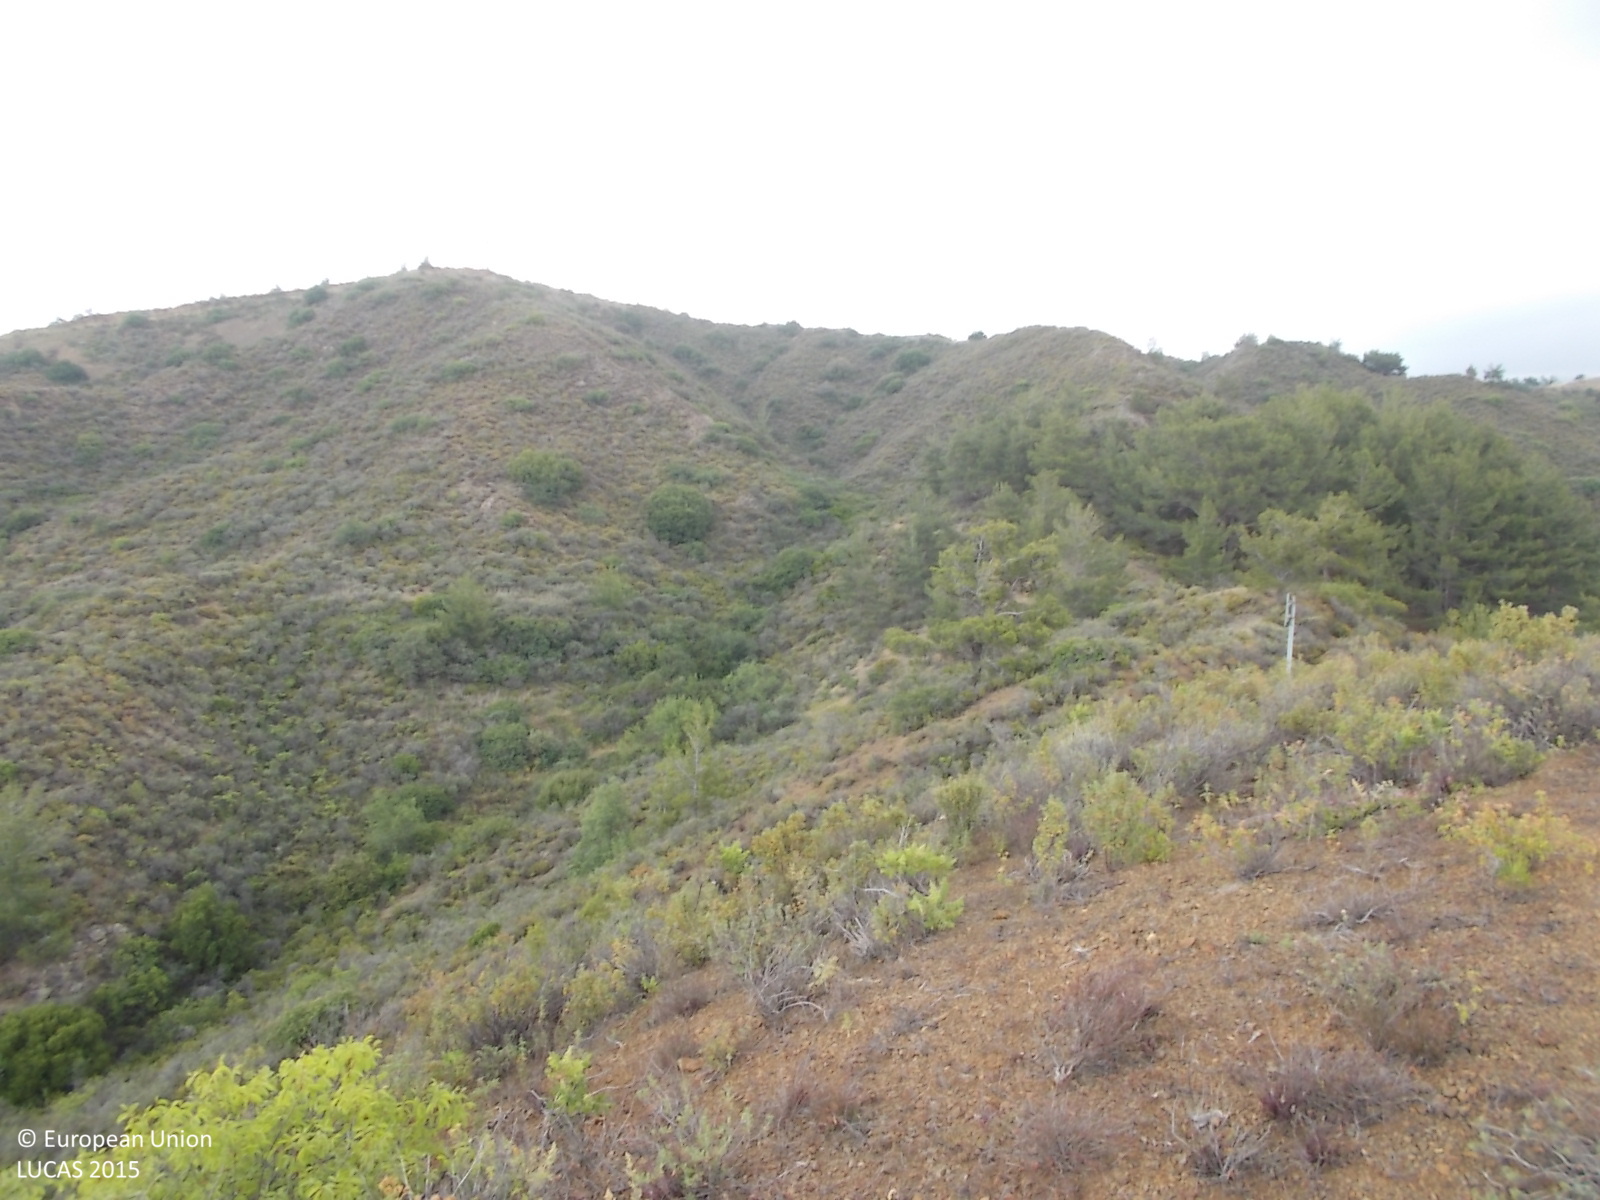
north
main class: Shrubland
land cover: Shrubland without tree cover
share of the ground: 10 - 25 %
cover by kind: unconsolidated bare surface 80 %, shrubs 20 %
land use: Semi-natural and natural areas not in use
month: June
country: CY
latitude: 34.8718
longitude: 32.8415
